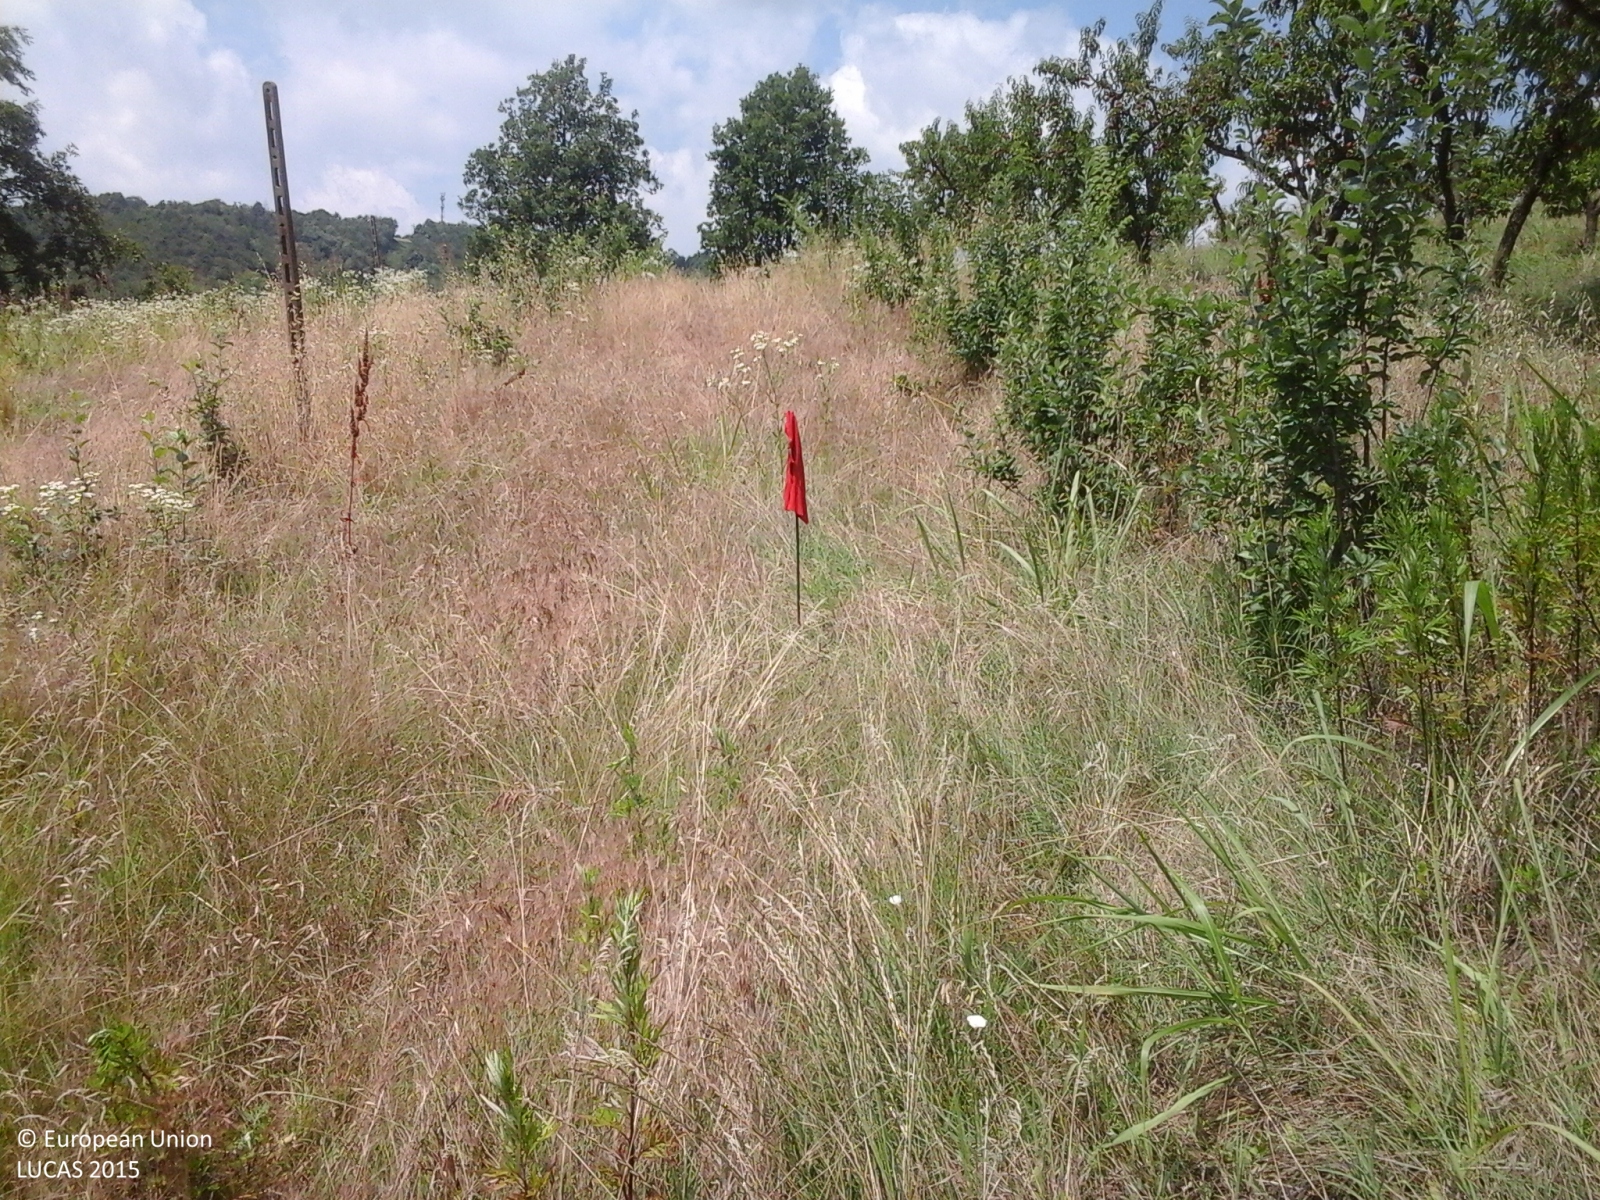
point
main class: Cropland
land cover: Other fruit trees and berries
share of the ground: > 75 %
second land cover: Grassland without tree/shrub cover
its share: > 75 %
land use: Agriculture (excluding fallow land and kitchen gardens)
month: June
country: IT
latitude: 45.0566
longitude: 8.2128
